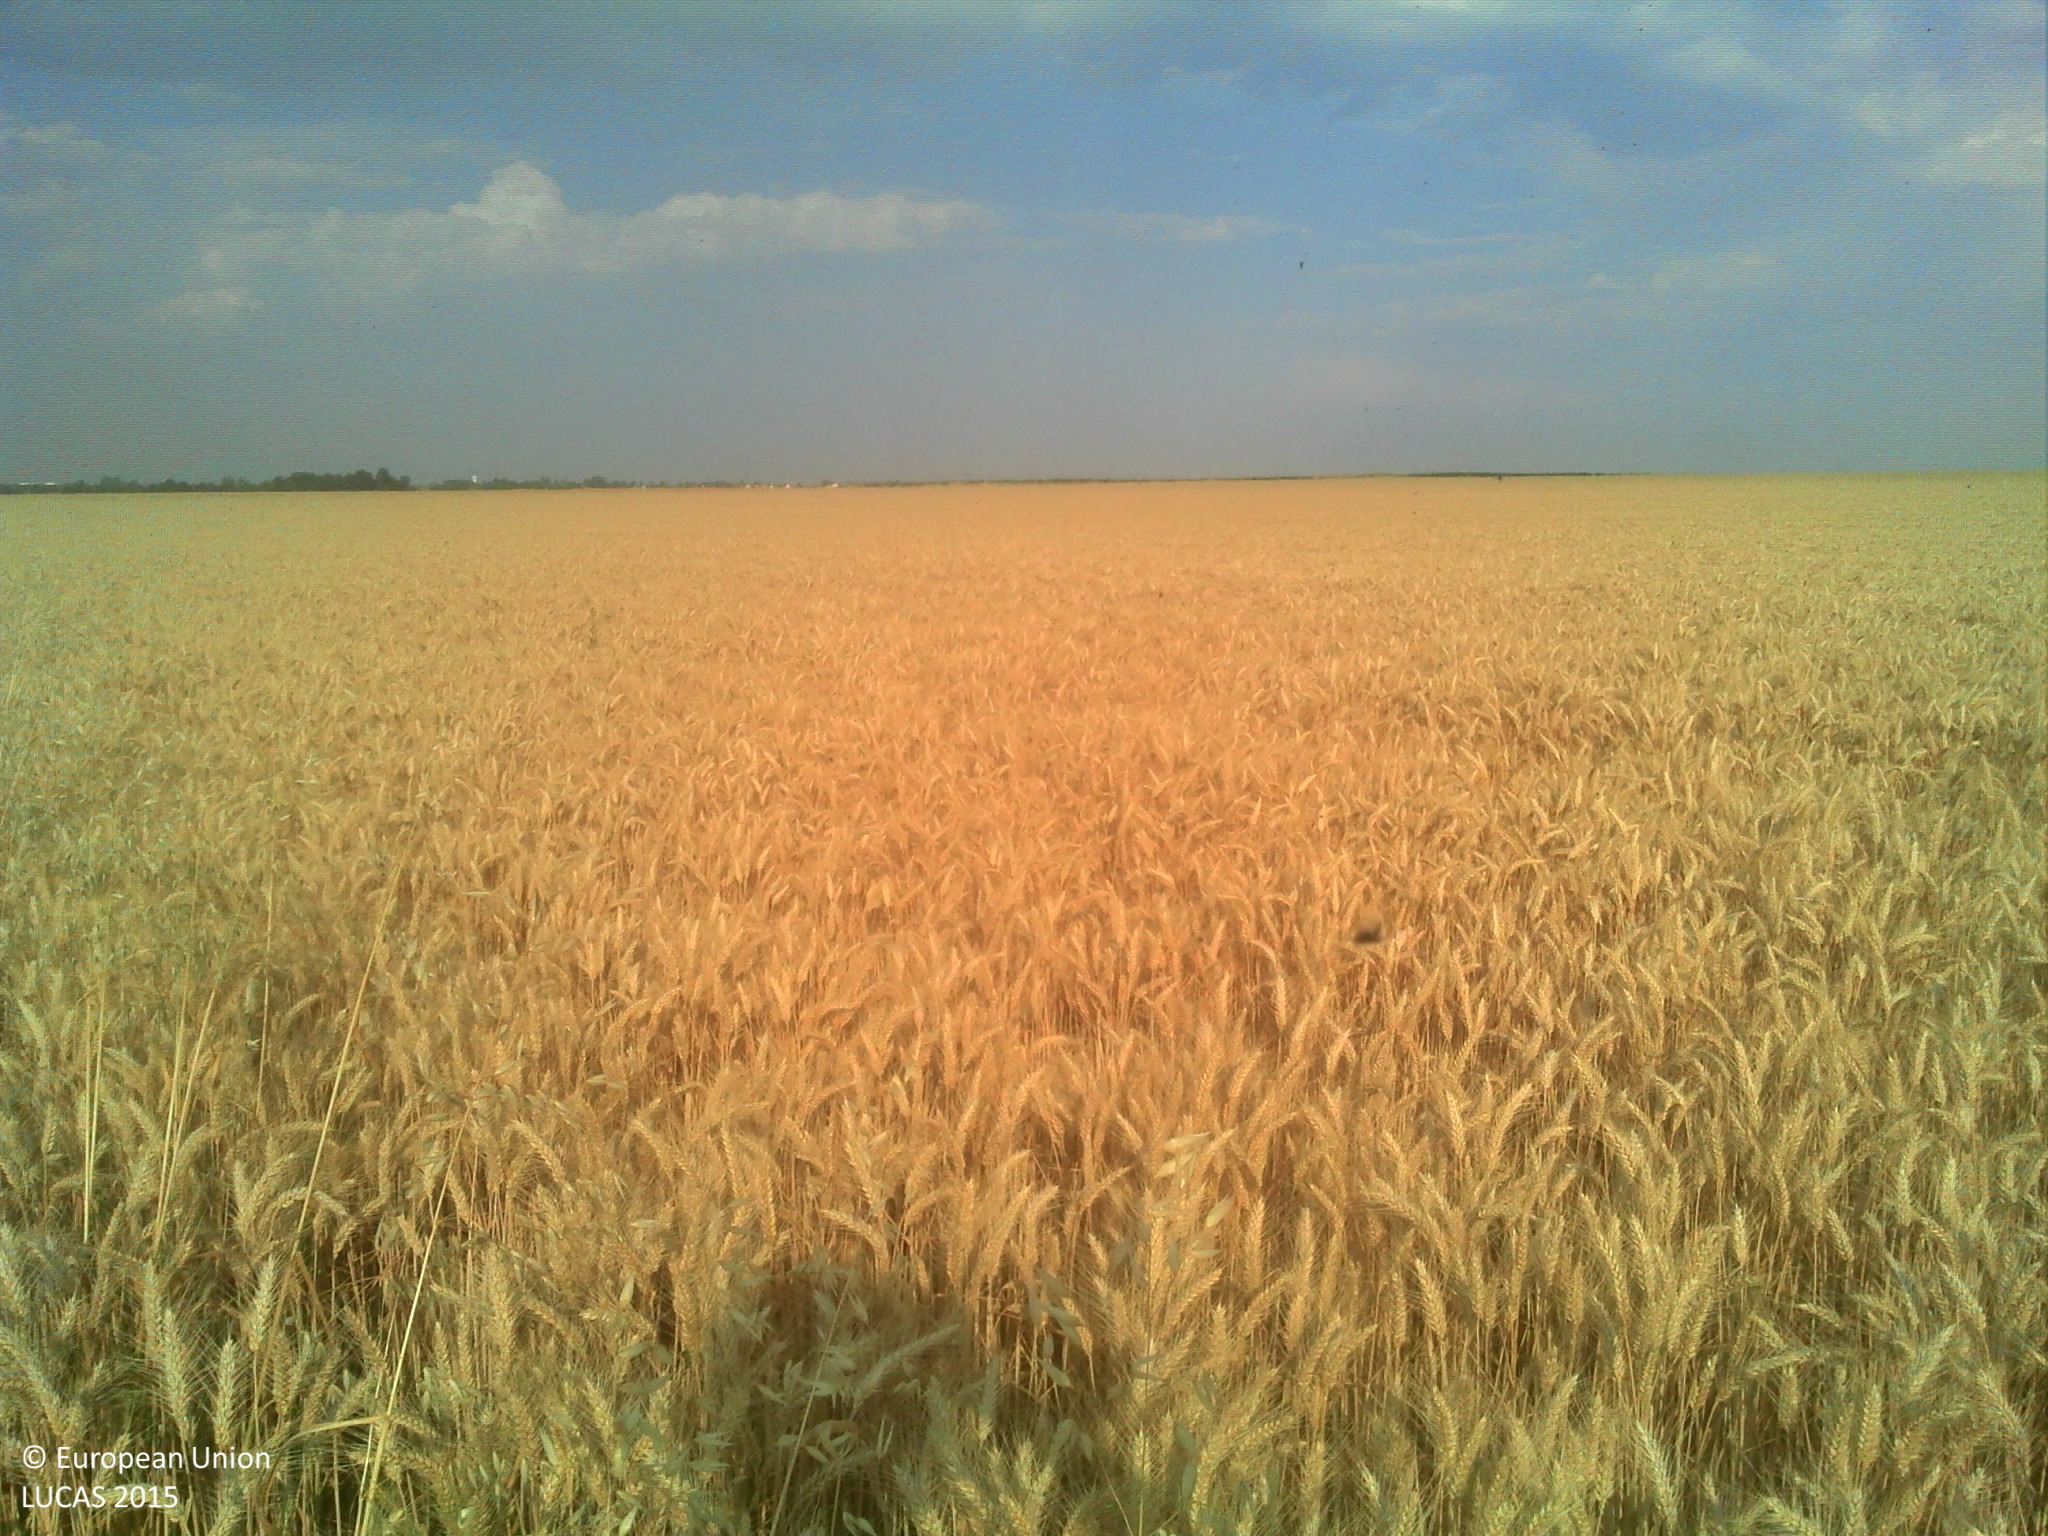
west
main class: Cropland
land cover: Durum wheat
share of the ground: > 75 %
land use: Agriculture (excluding fallow land and kitchen gardens)
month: July
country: FR
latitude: 47.6316
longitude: 1.3743
